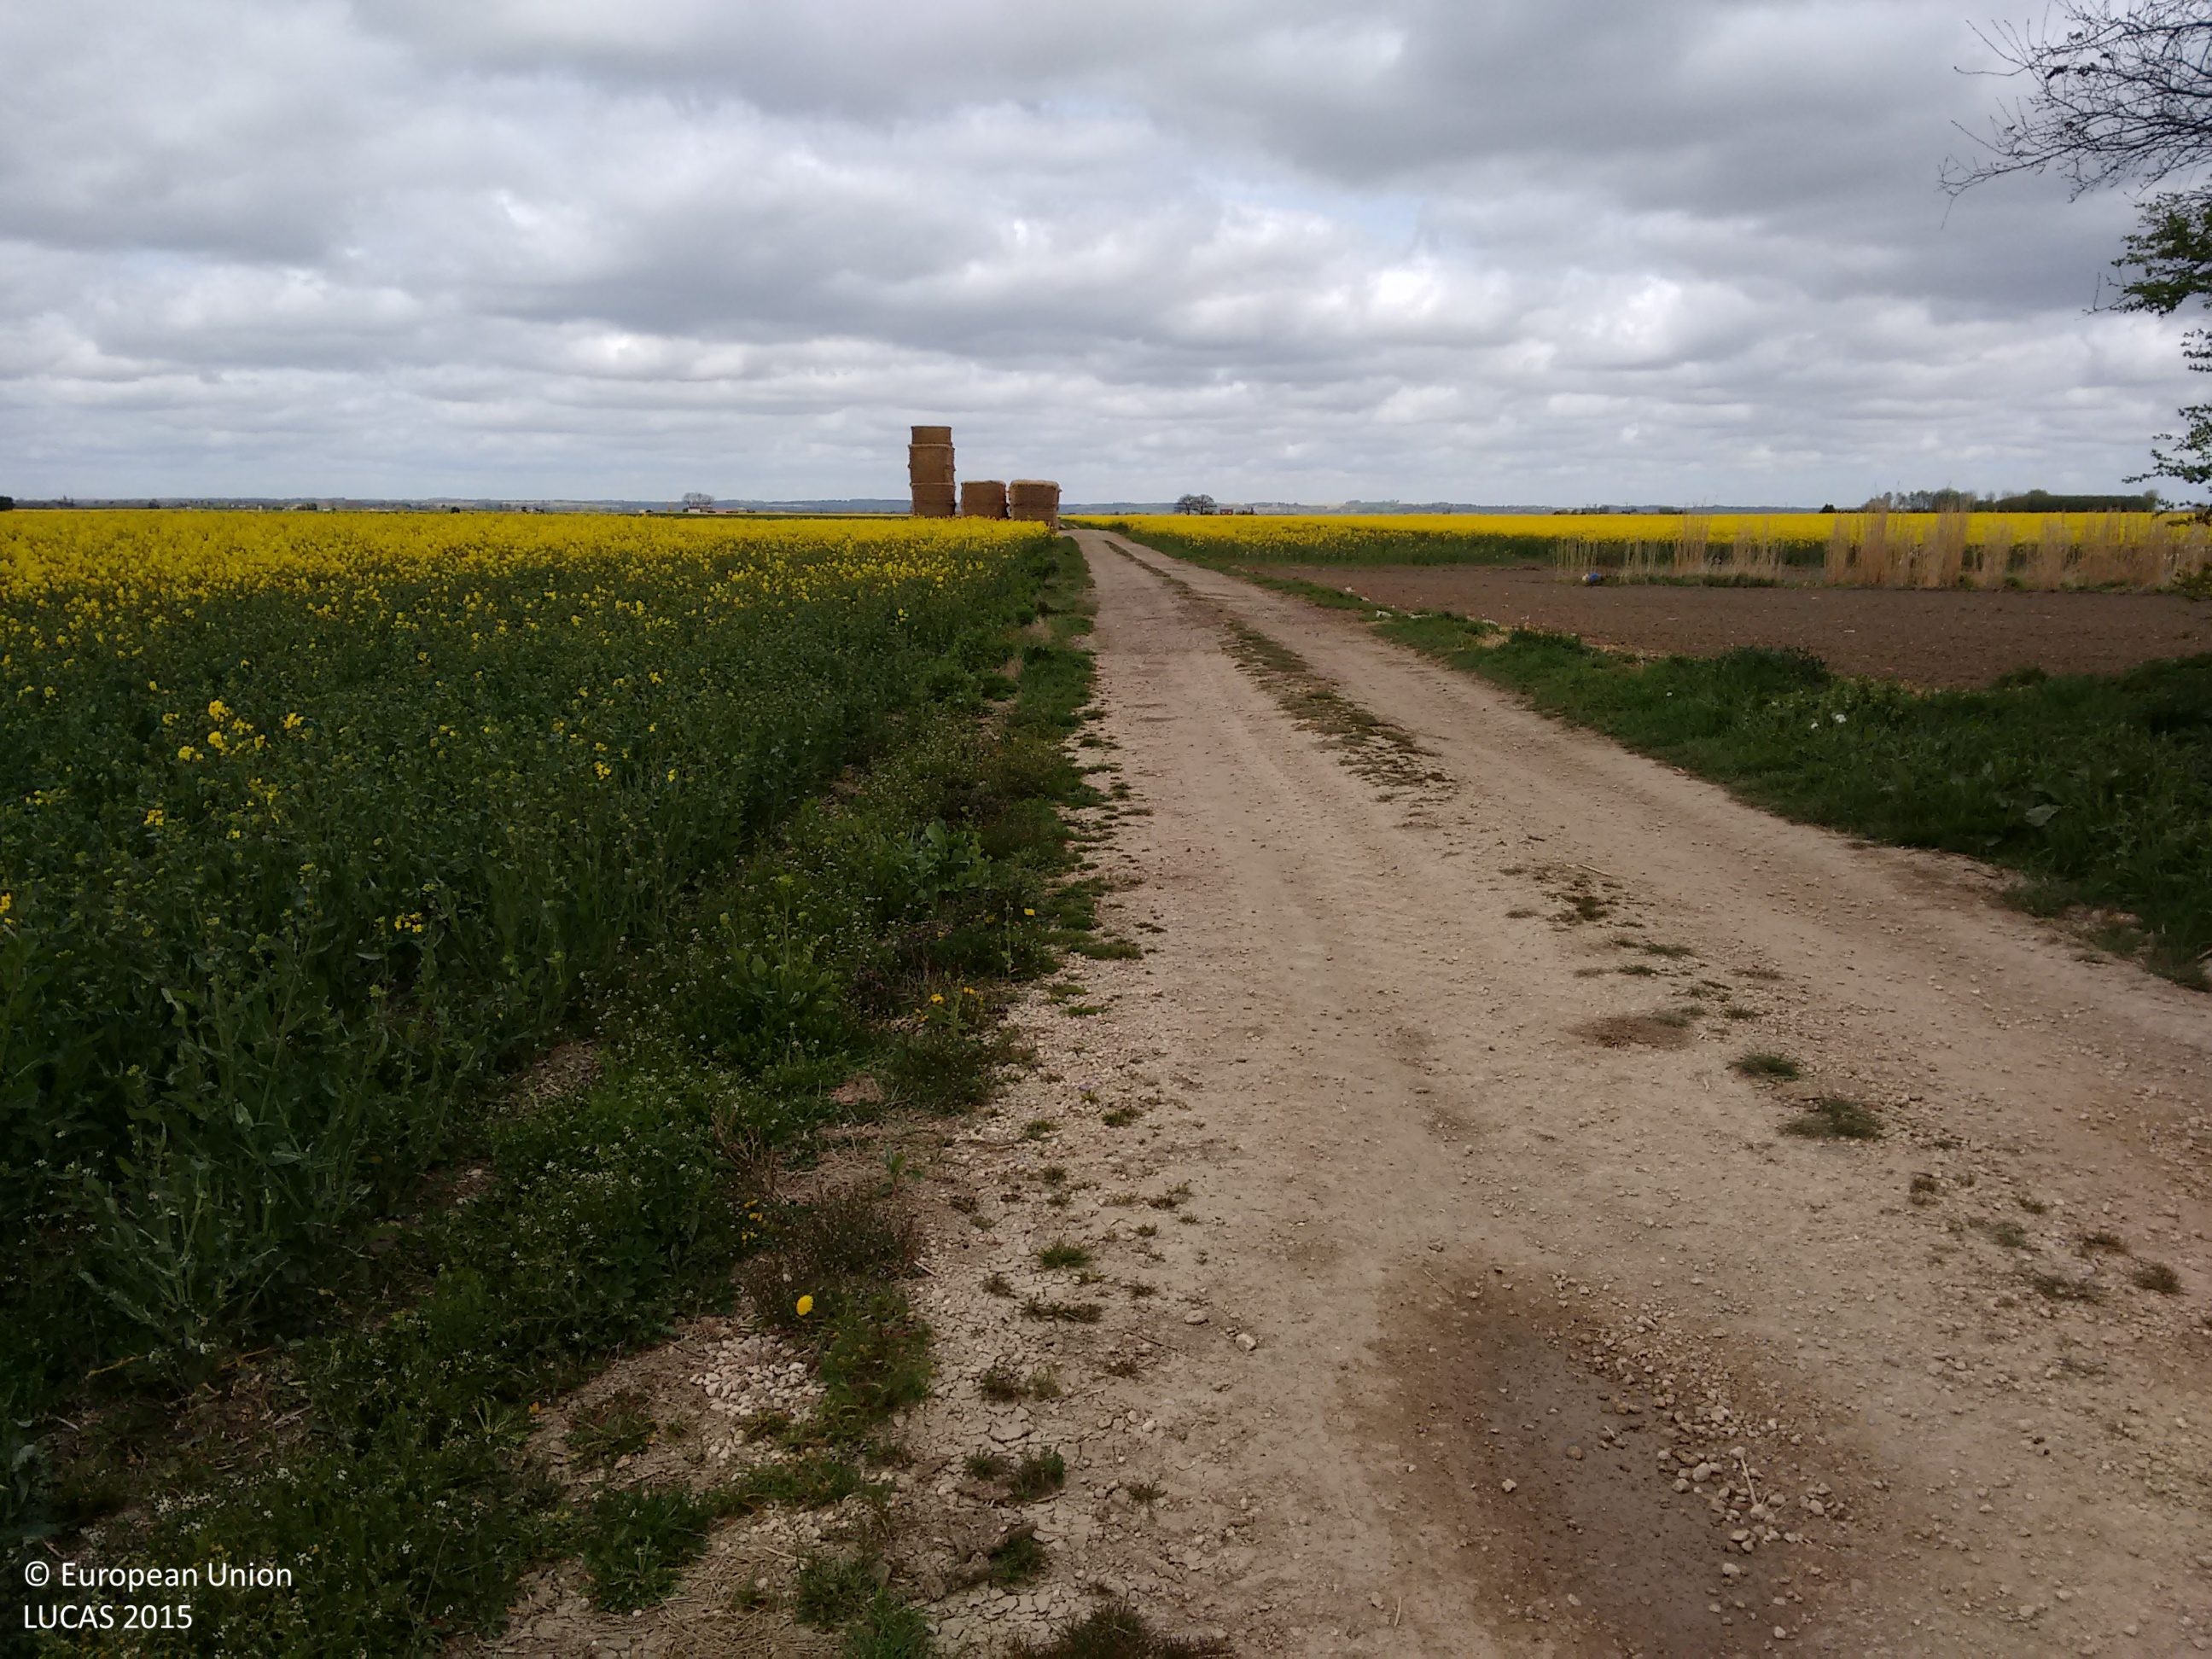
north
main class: Cropland
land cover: Rape and turnip rape
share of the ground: > 75 %
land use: Agriculture (excluding fallow land and kitchen gardens)
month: May
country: GB
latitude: 53.0632
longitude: 0.0449
